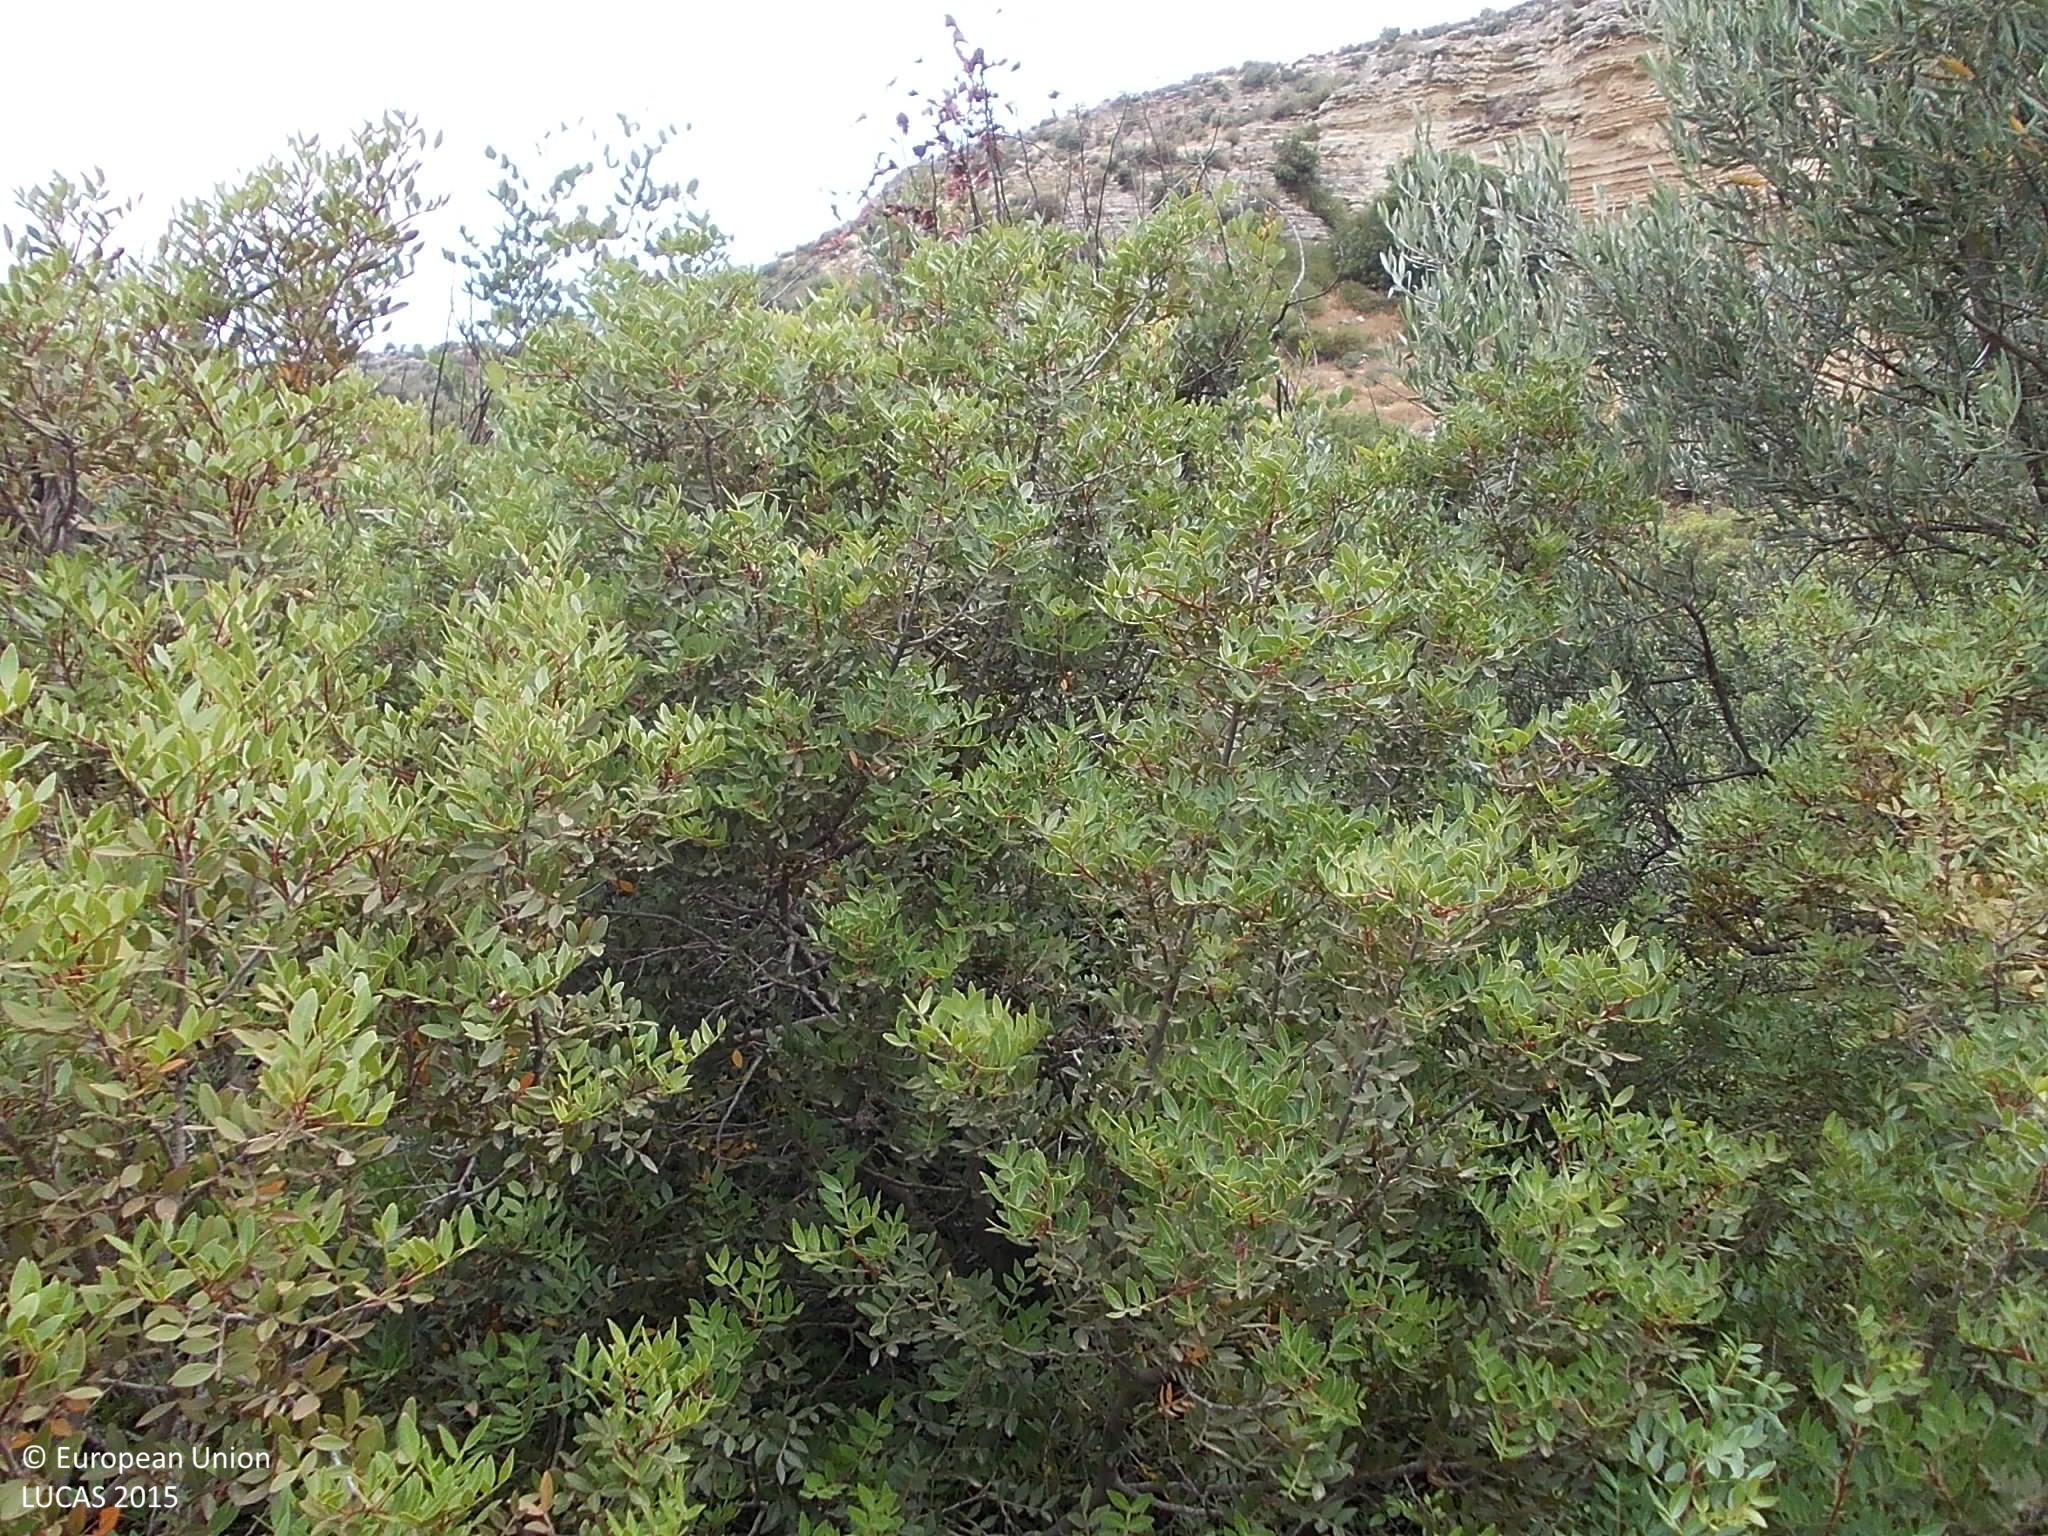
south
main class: Shrubland
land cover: Shrubland with sparse tree cover
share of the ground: > 75 %
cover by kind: shrubs 95 %, broadleaved forest trees 5 %
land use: Semi-natural and natural areas not in use
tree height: < 5 m
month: May
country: CY
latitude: 34.7158
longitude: 32.7917
